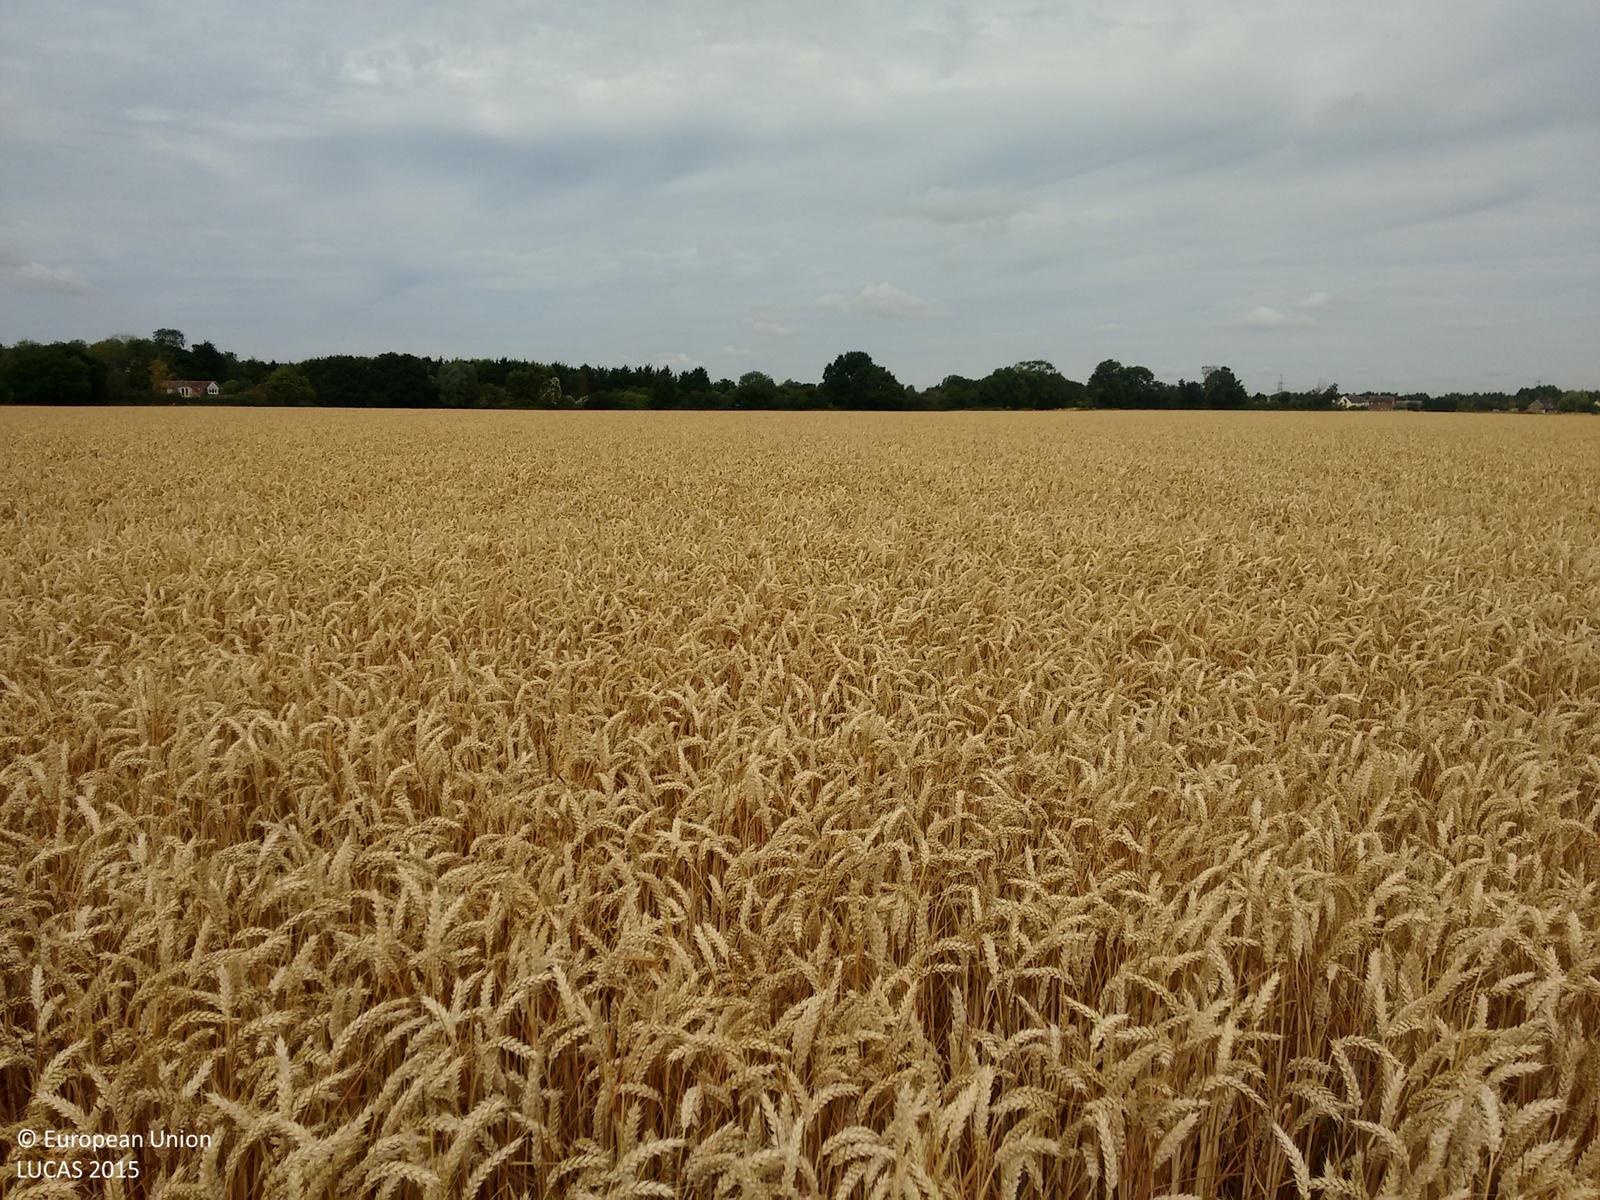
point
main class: Cropland
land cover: Common wheat
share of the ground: > 75 %
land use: Agriculture (excluding fallow land and kitchen gardens)
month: July
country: GB
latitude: 51.7659
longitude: 0.5687
